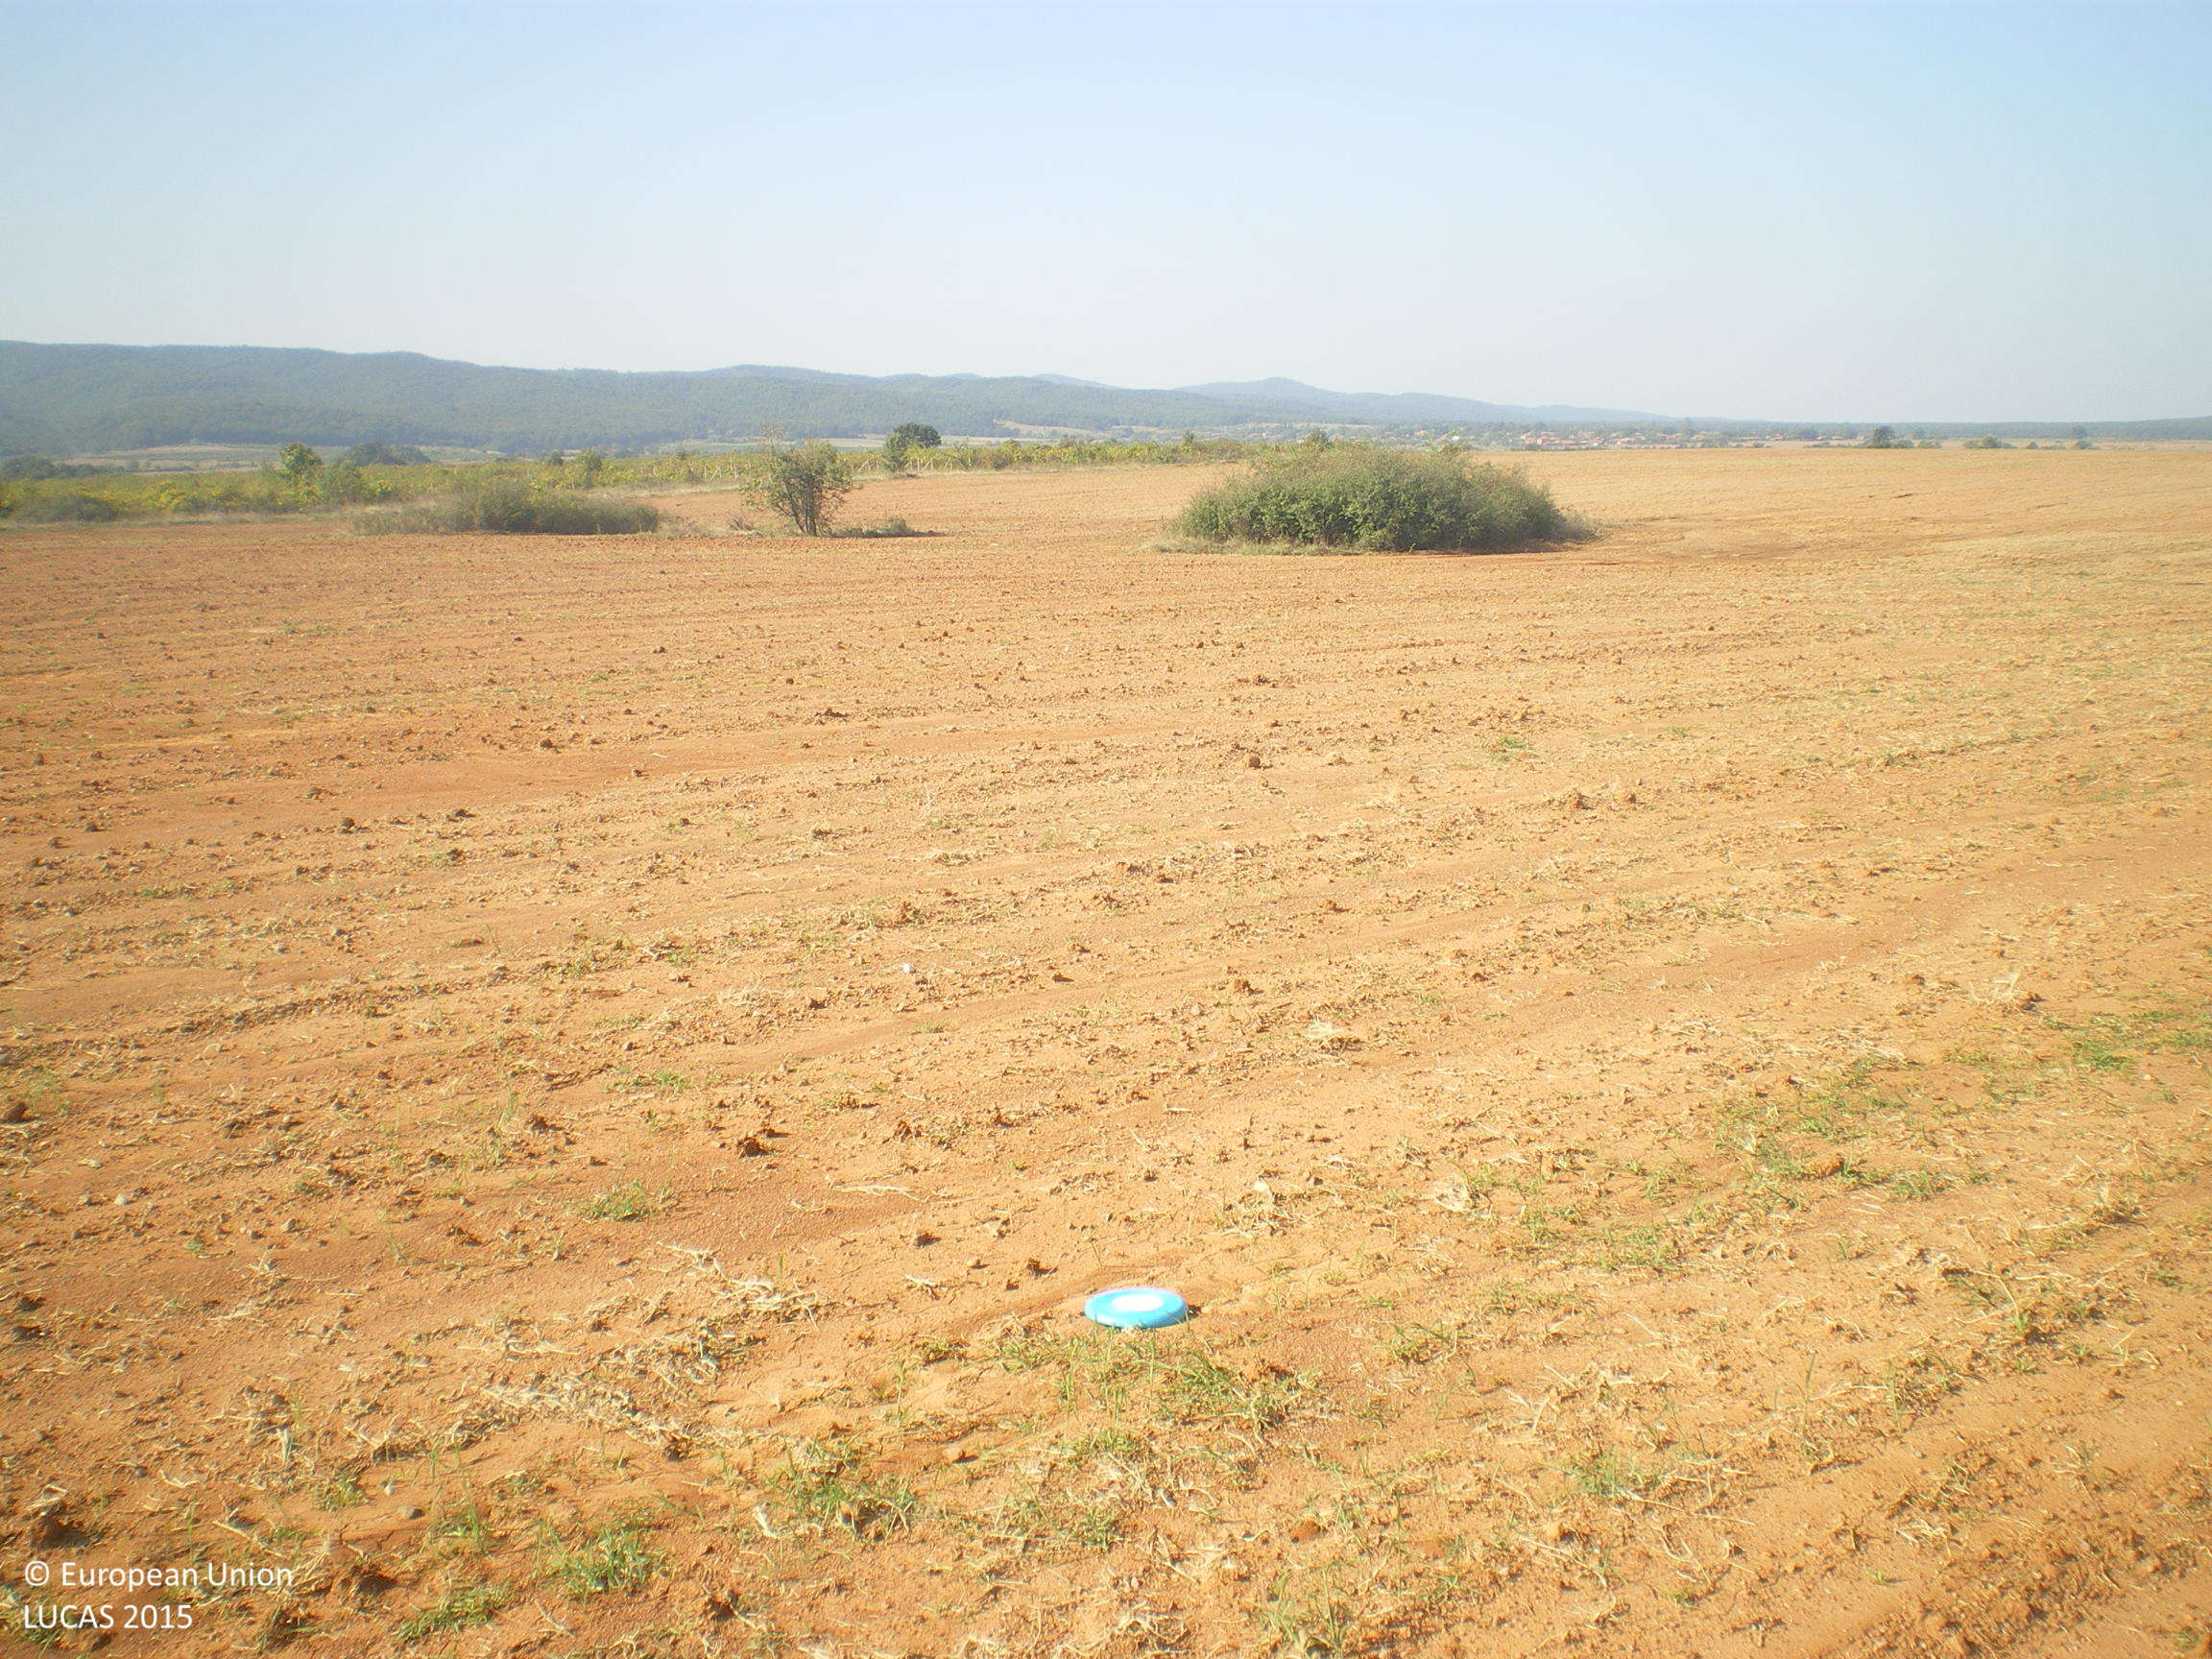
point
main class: Cropland
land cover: Common wheat
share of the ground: < 10 %
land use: Agriculture (excluding fallow land and kitchen gardens)
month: September
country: BG
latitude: 41.7762
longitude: 25.8895
